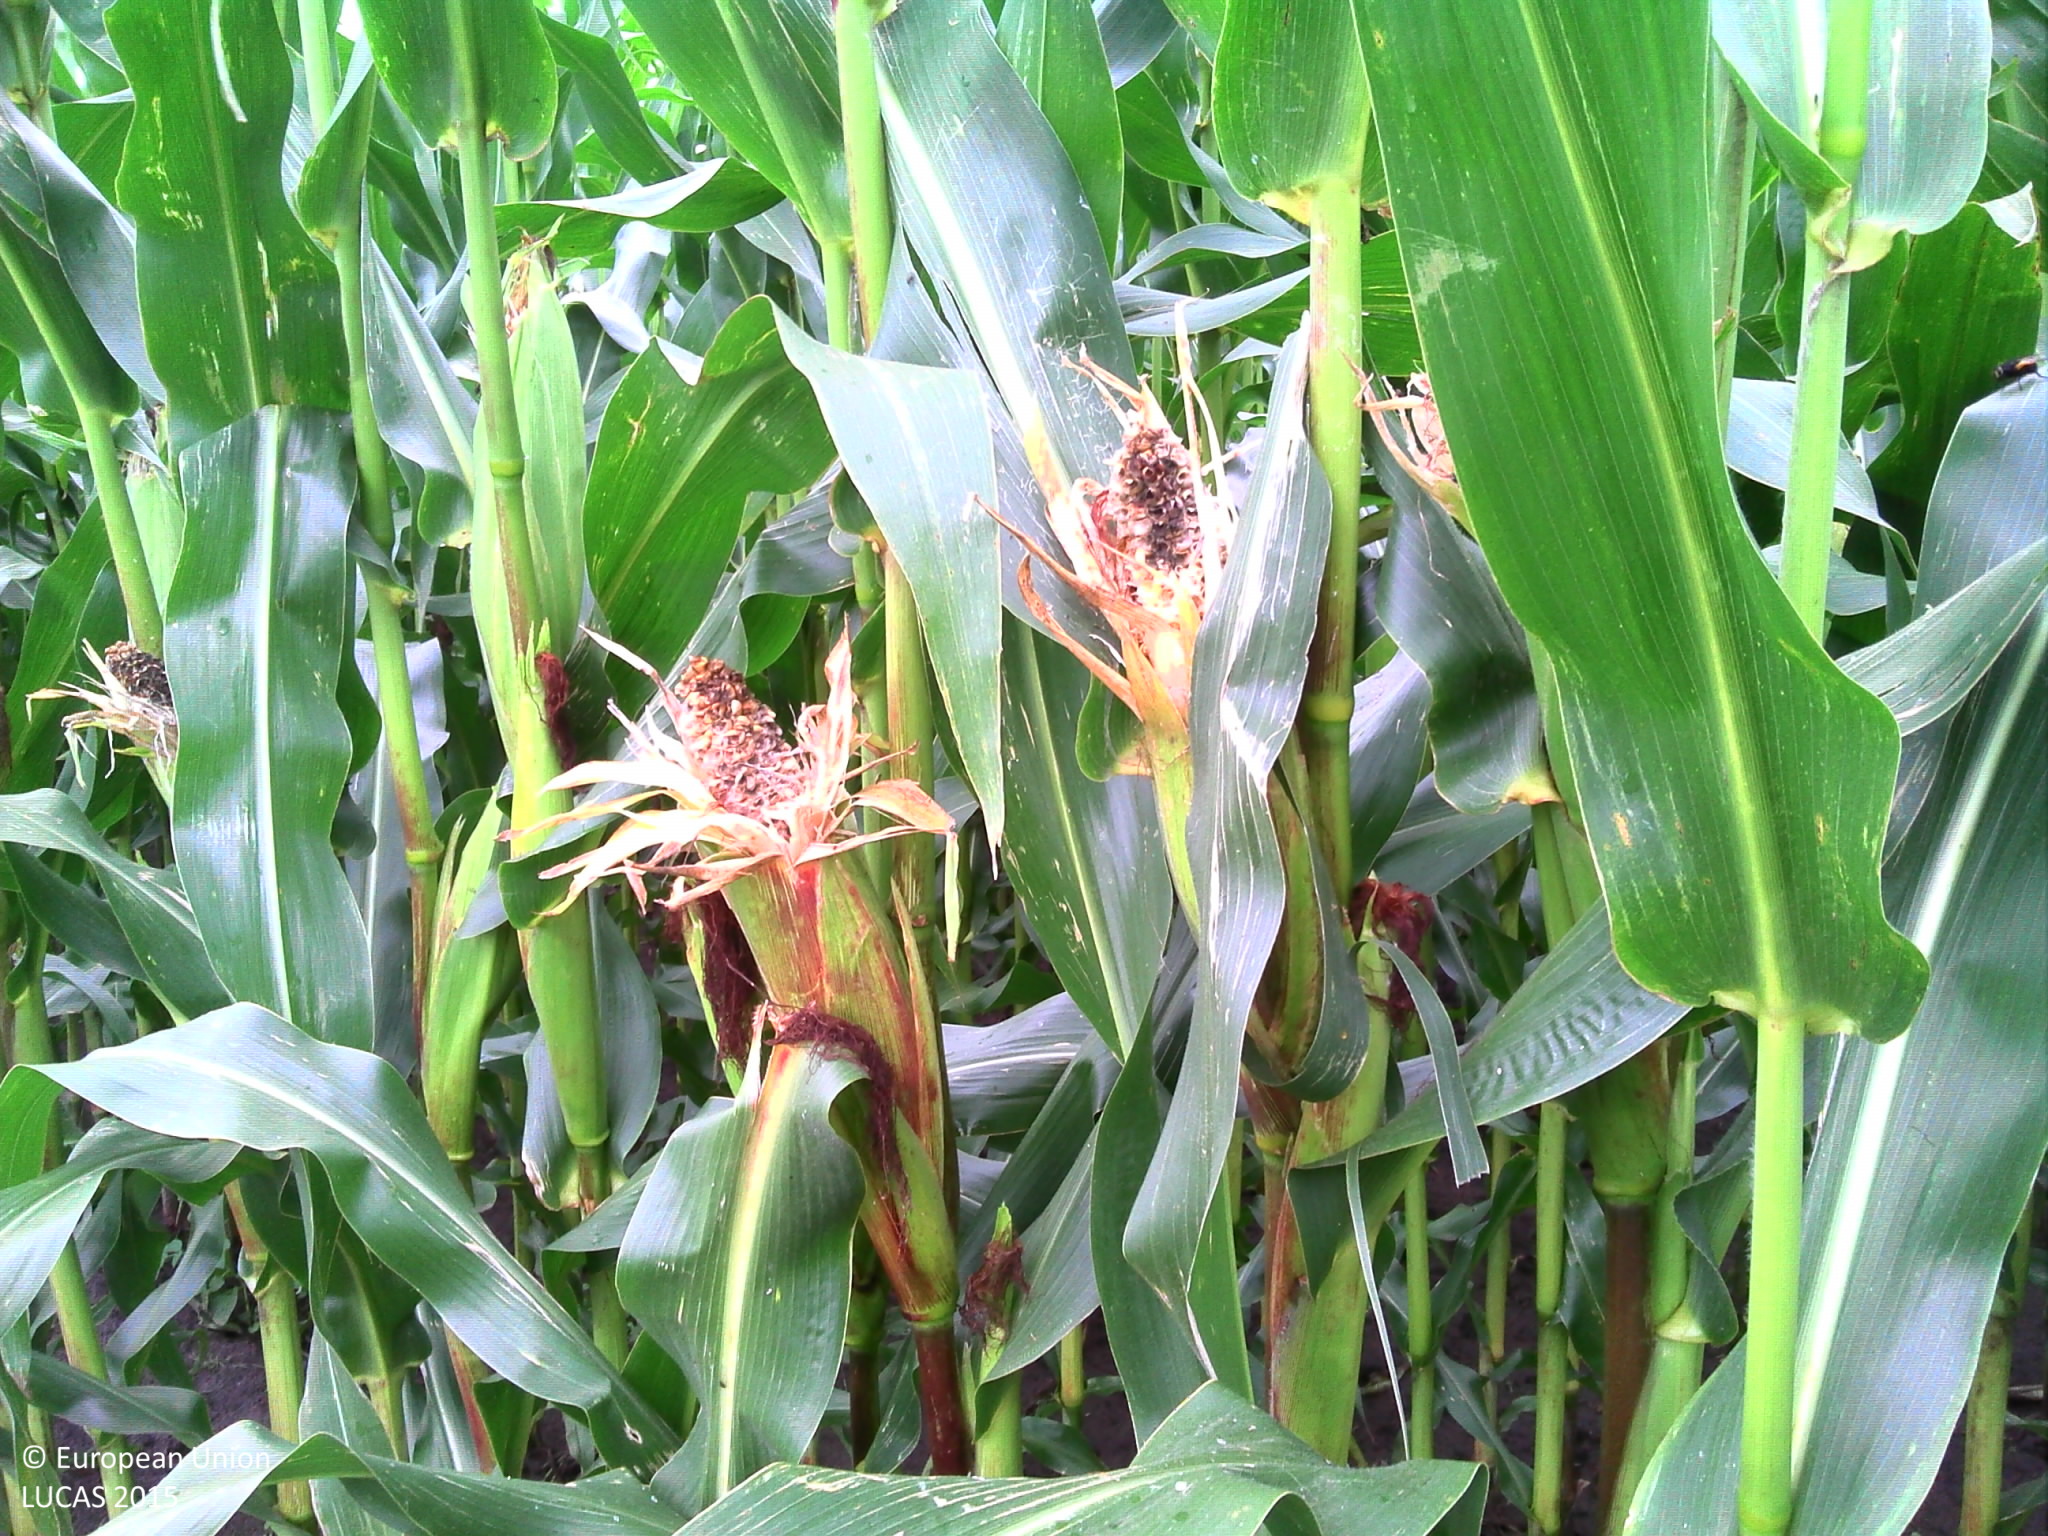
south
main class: Cropland
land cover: Maize
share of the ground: > 75 %
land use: Agriculture (excluding fallow land and kitchen gardens)
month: September
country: BE
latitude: 51.1294
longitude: 3.0884
